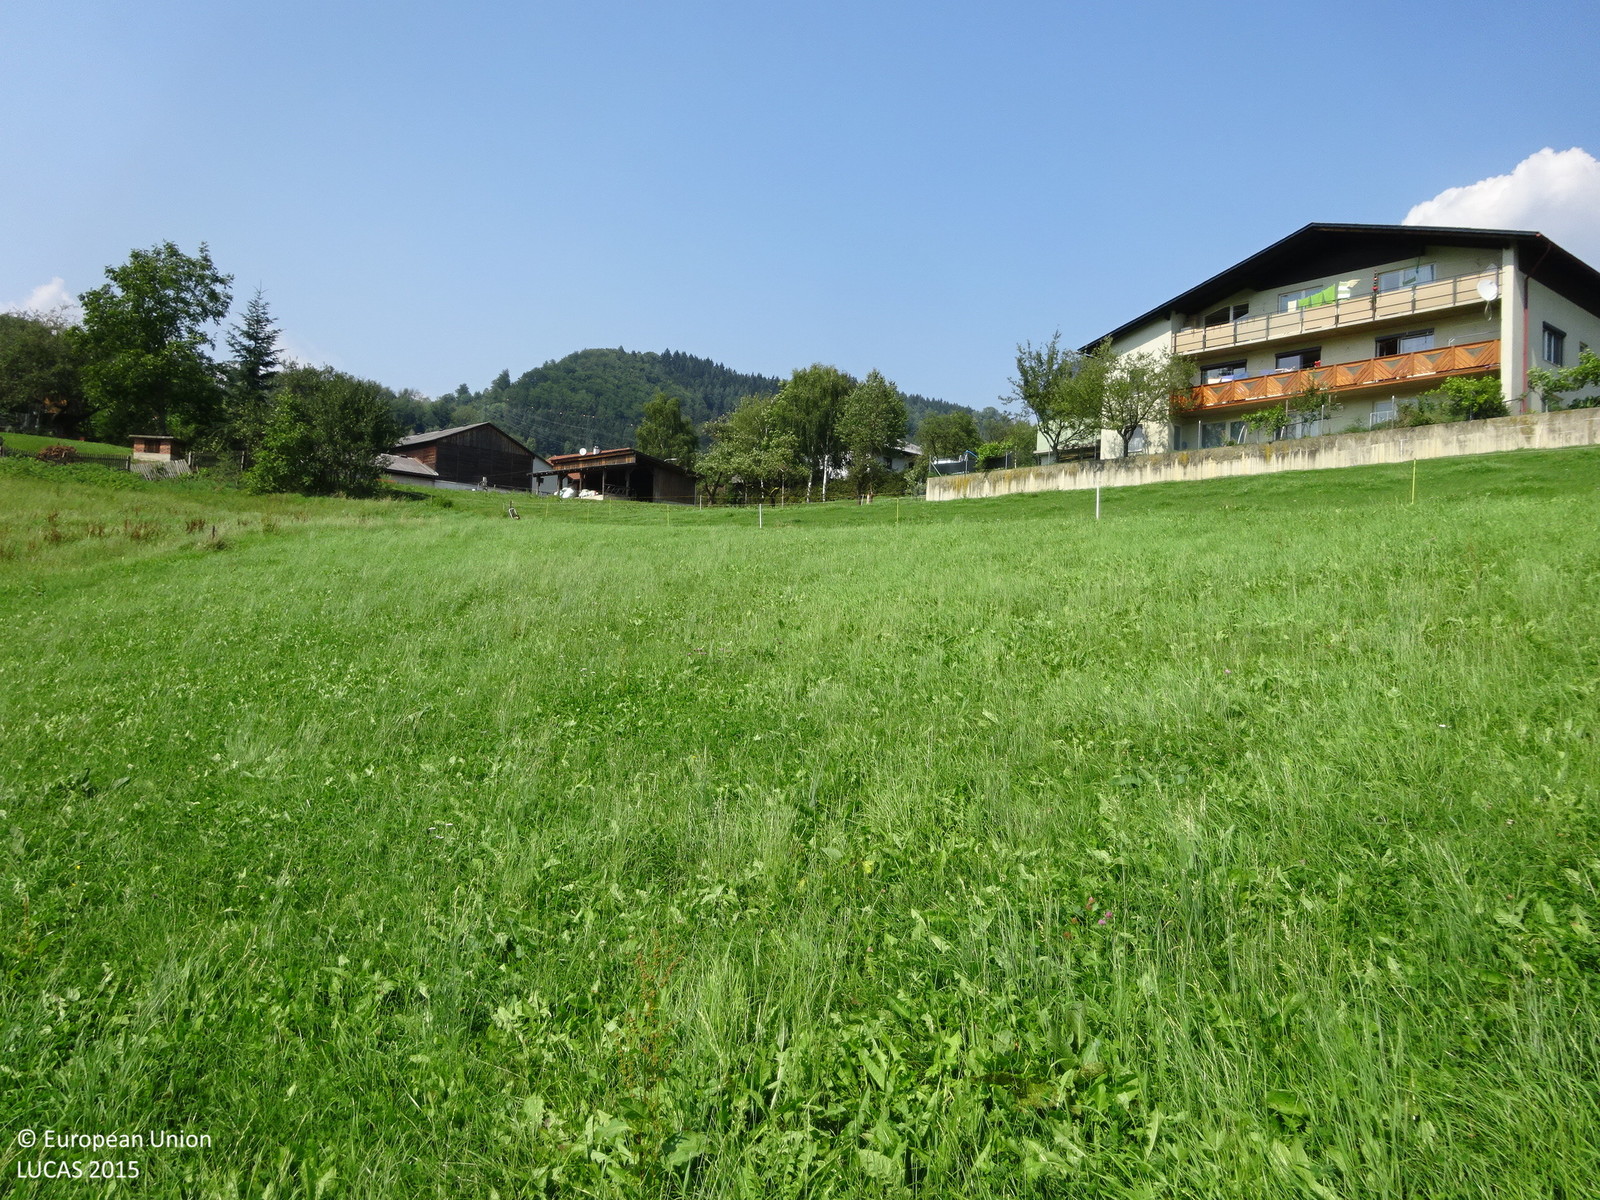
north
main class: Grassland
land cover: Grassland without tree/shrub cover
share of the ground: > 75 %
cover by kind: herbaceous plants 100 %
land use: Agriculture (excluding fallow land and kitchen gardens)
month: August
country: AT
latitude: 47.4113
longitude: 15.2882
